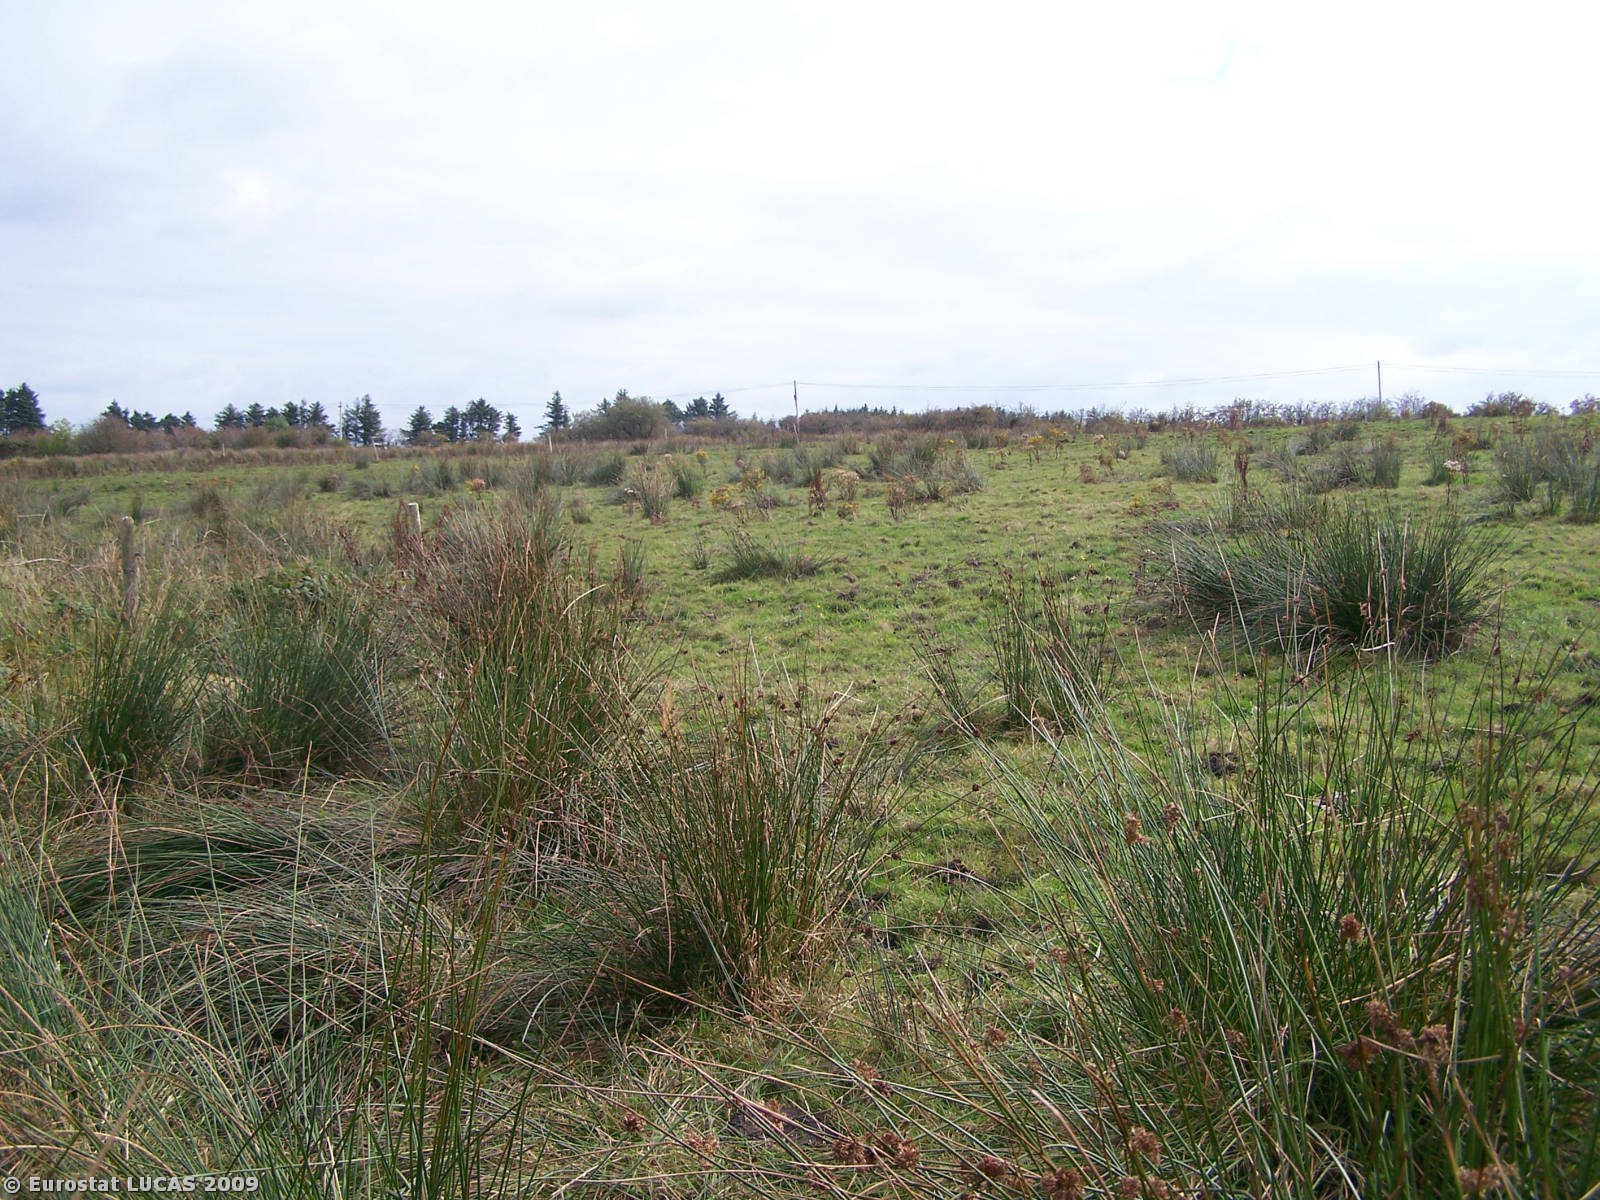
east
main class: Grassland
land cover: Grassland without tree/shrub cover
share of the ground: > 75 %
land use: Agriculture (excluding fallow land and kitchen gardens)
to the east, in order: Grassland without tree/shrub cover; Fences; Abandoned hedges; Fences; Grassland without tree/shrub cover; Fences; Grassland without tree/shrub cover; Fences; Abandoned hedges; Paved roads, cycling and walking lanes; Abandoned hedges; Electric lines; Ditches and canals; Grassland without tree/shrub cover
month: September
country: IE
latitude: 52.2801
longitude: -9.0196
